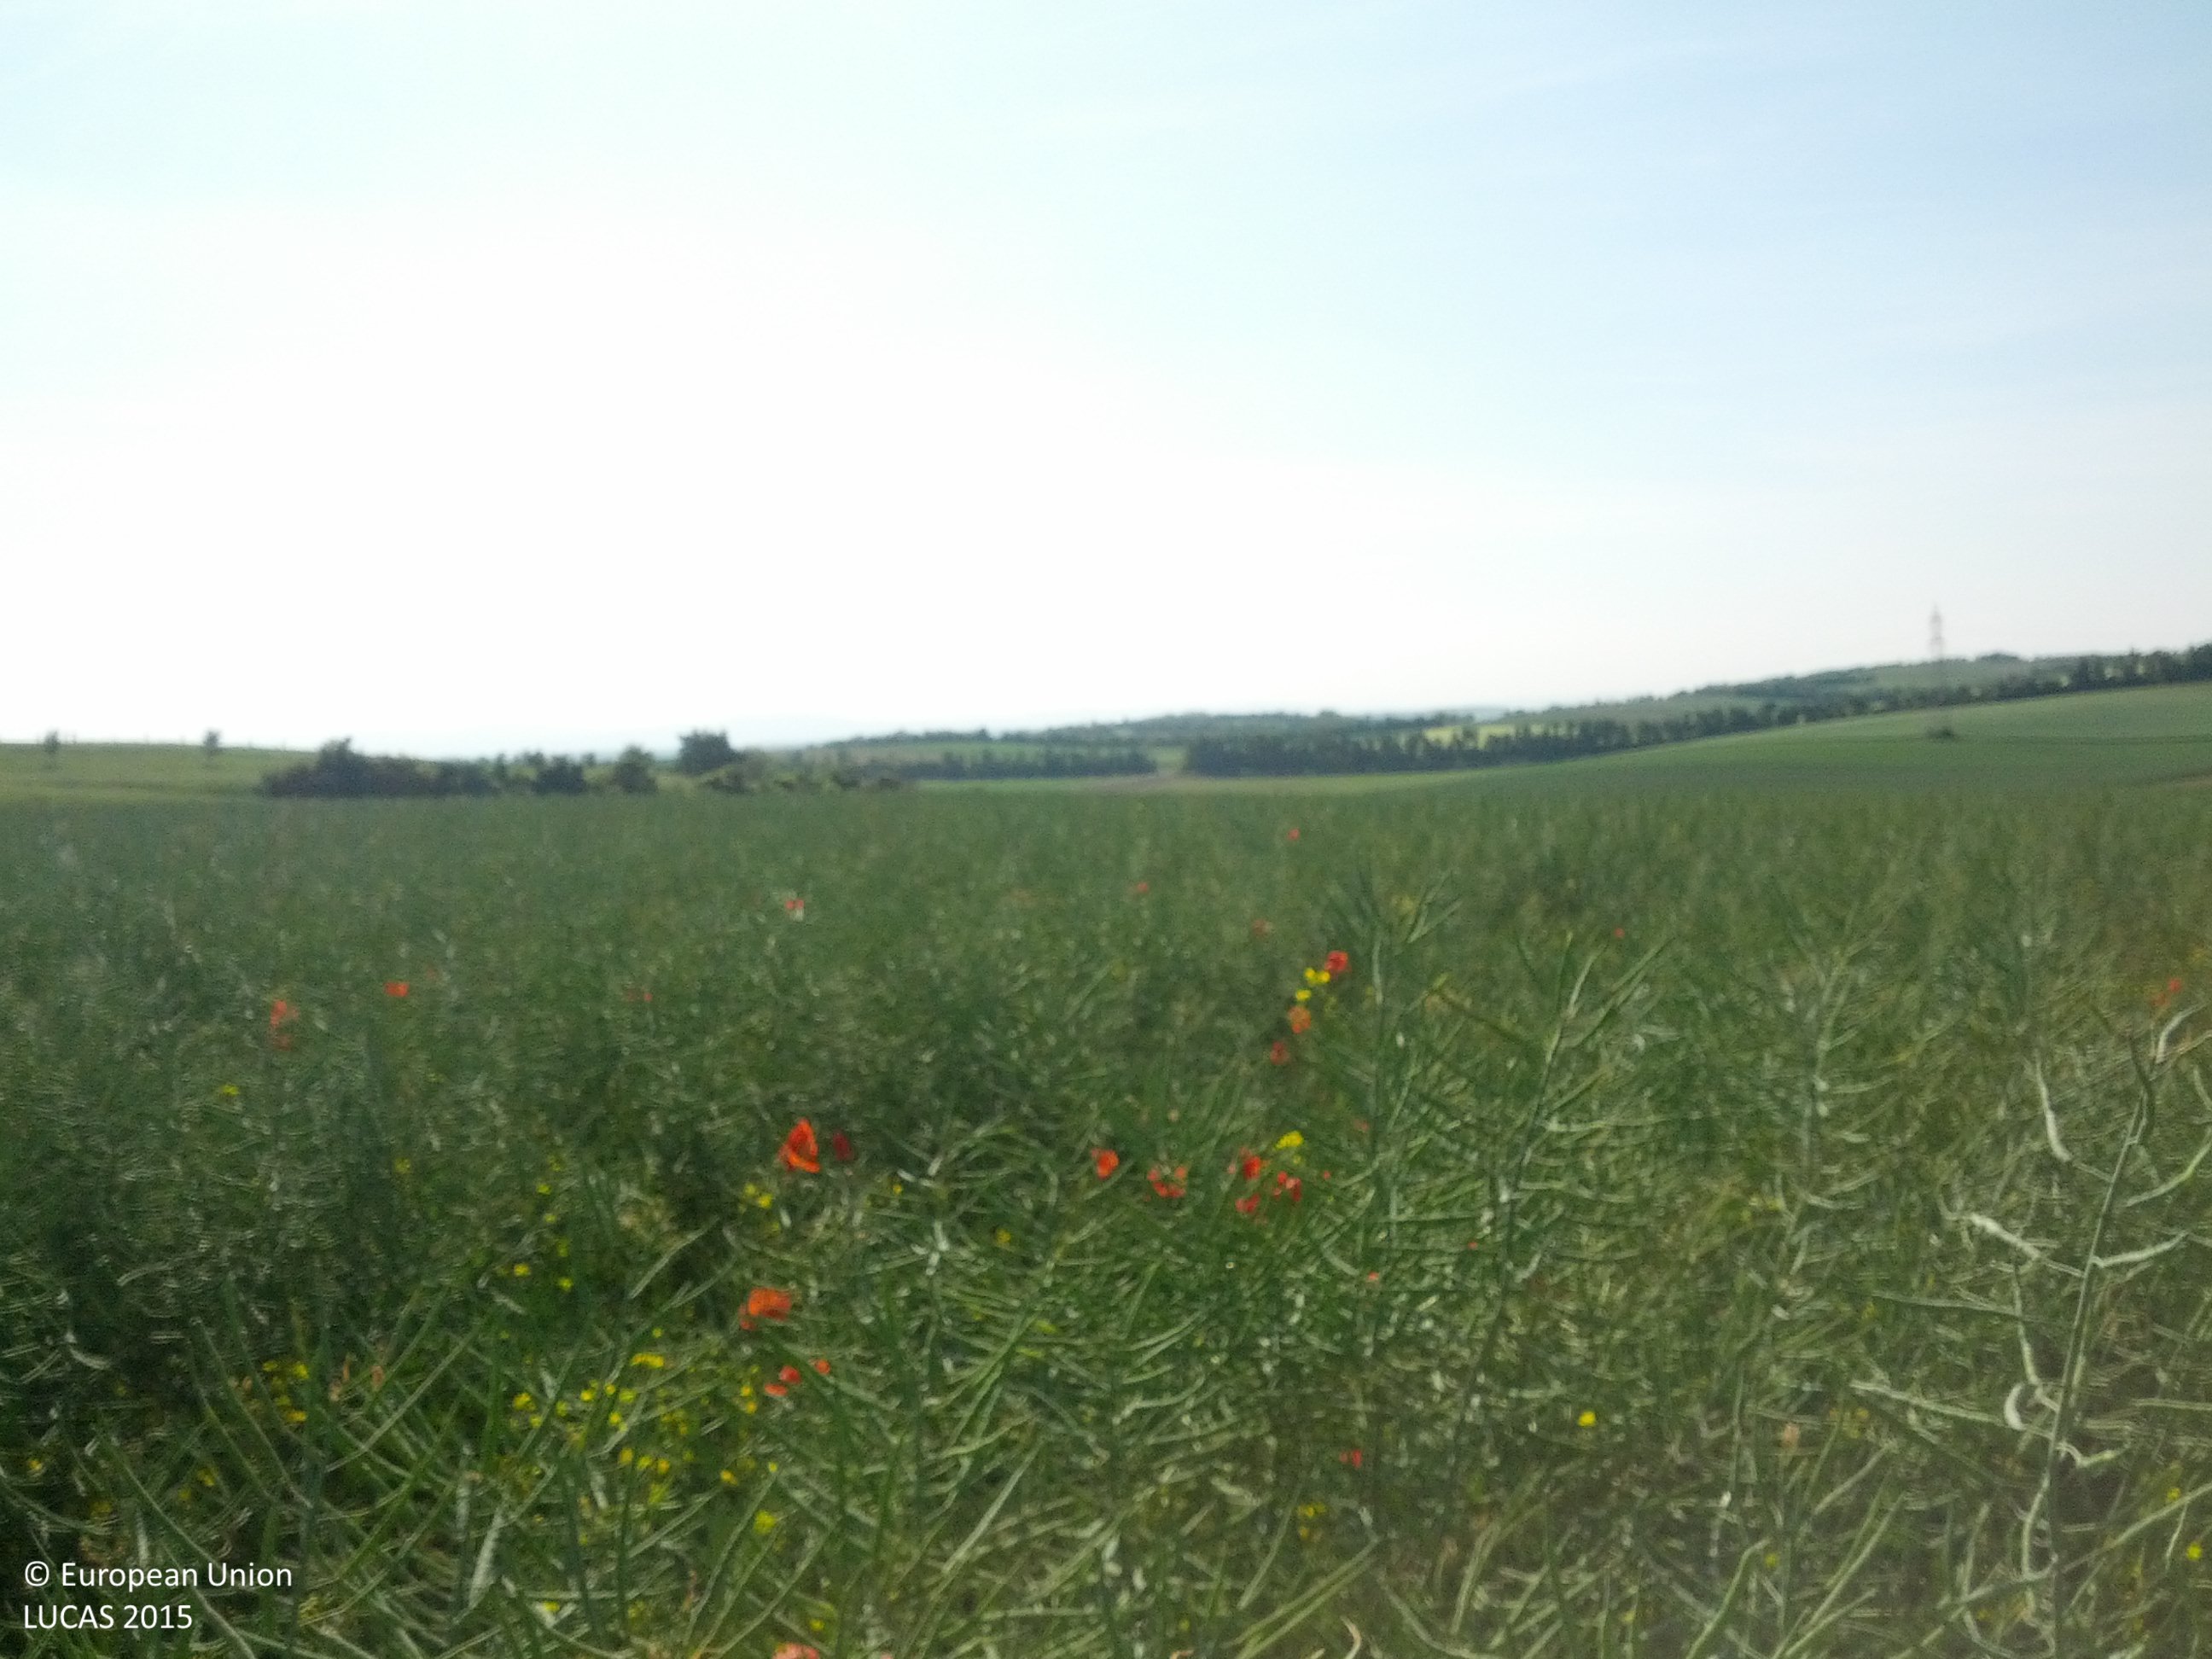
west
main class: Cropland
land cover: Rape and turnip rape
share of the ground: > 75 %
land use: Agriculture (excluding fallow land and kitchen gardens)
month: May
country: AT
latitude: 48.0573
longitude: 16.6743
